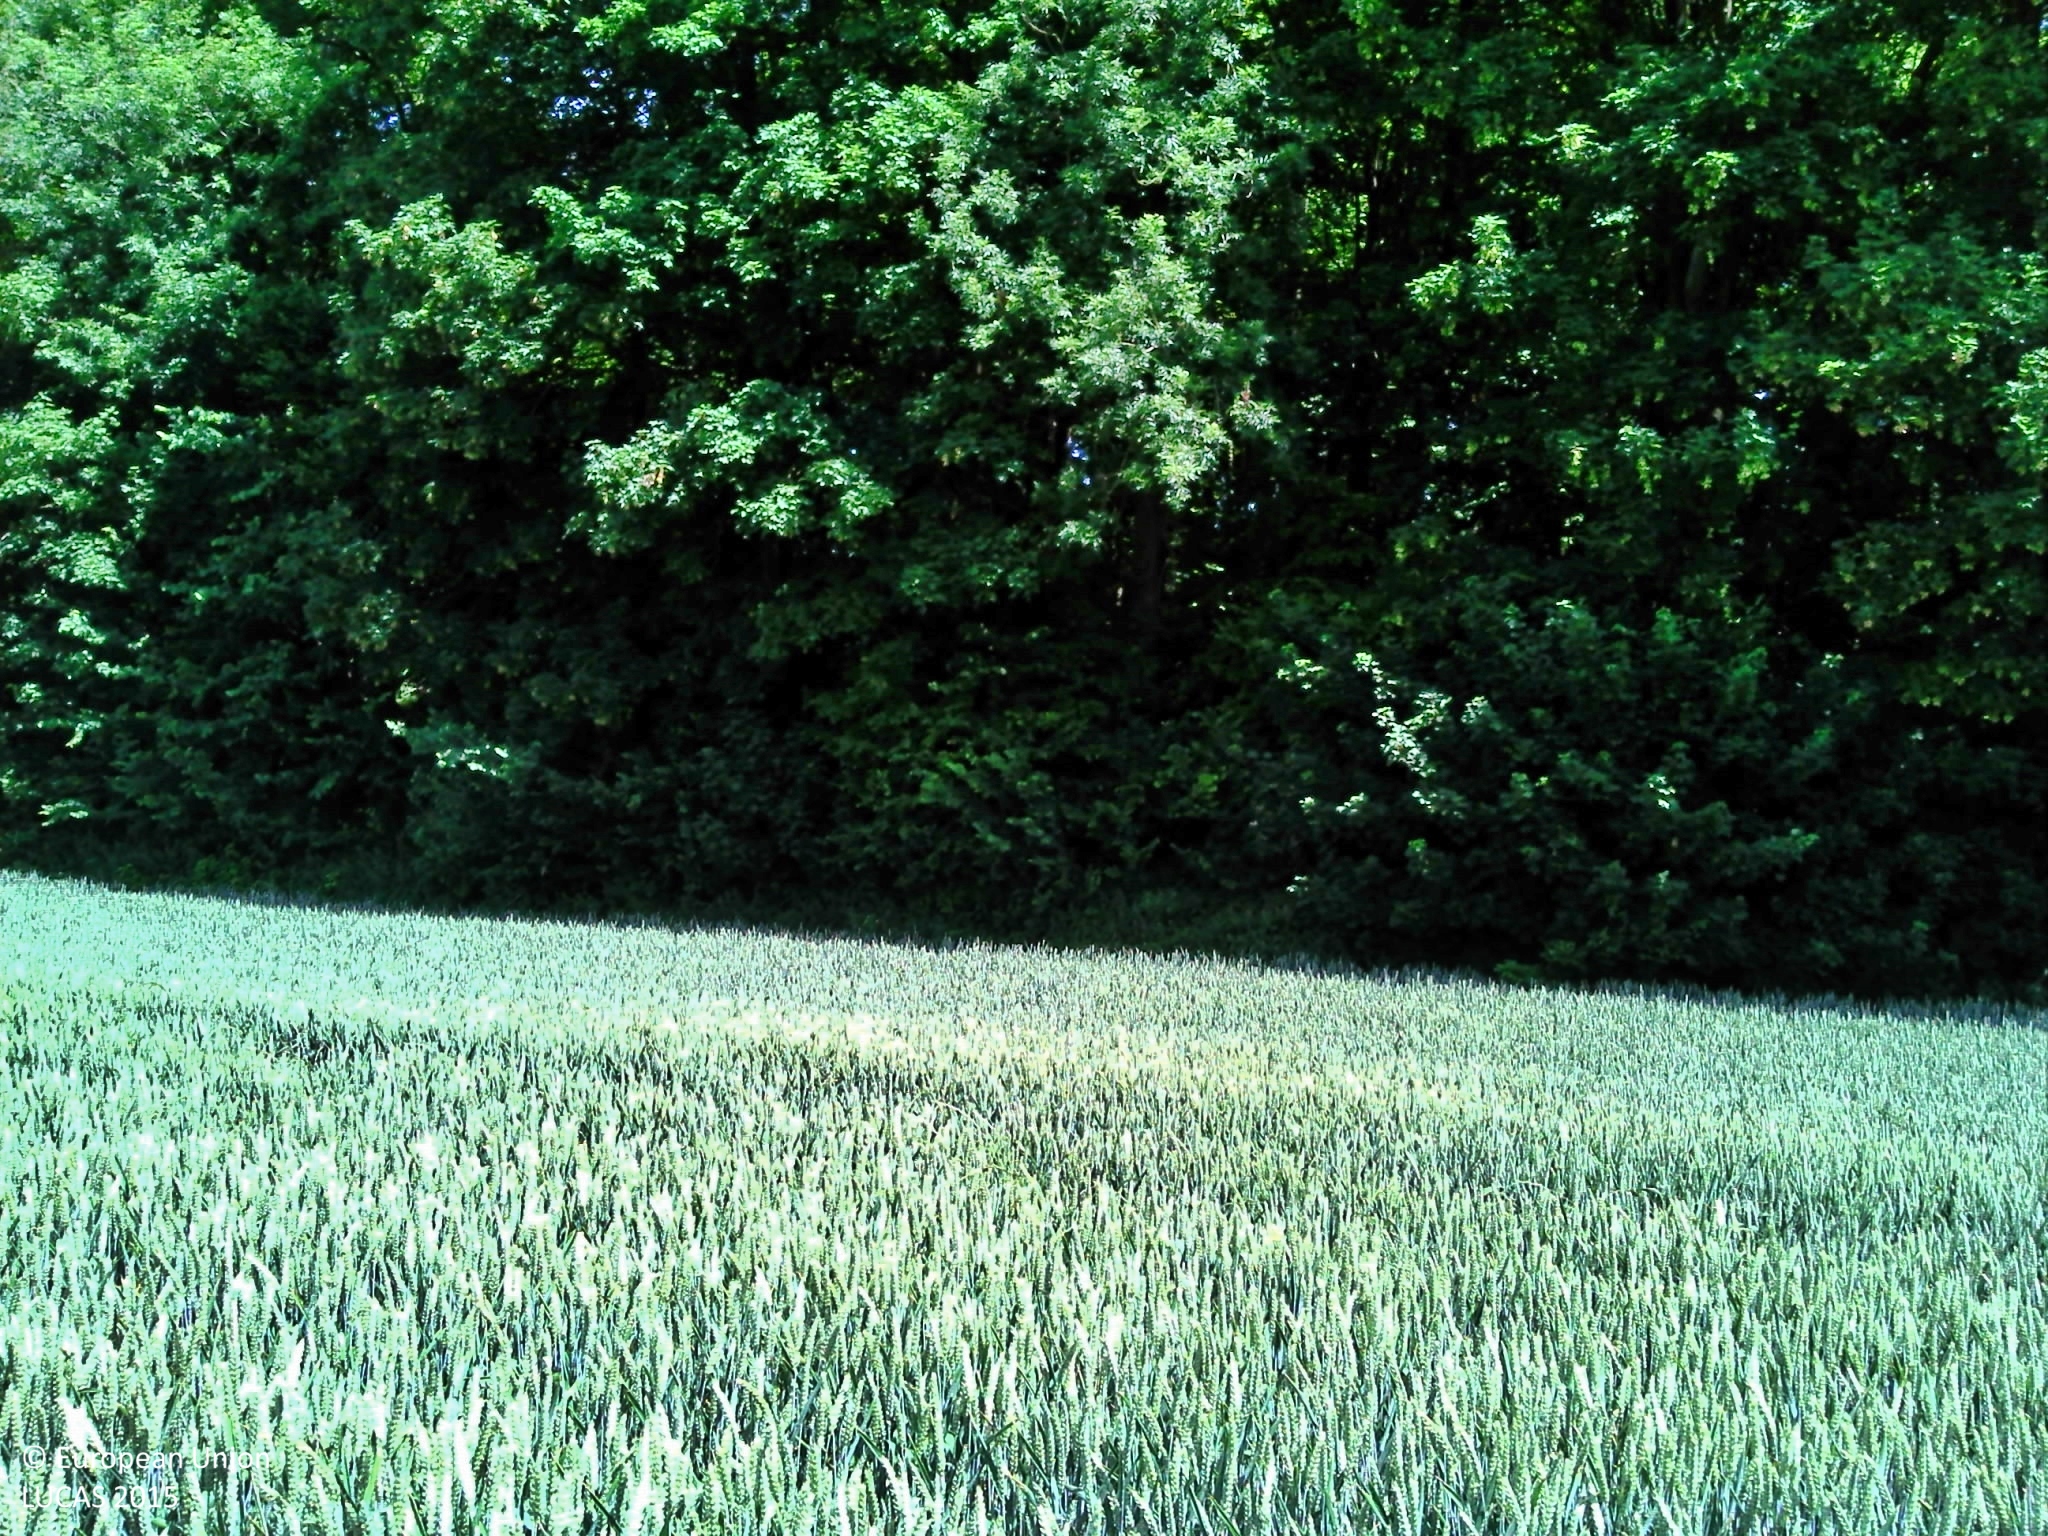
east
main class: Cropland
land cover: Common wheat
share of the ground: > 75 %
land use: Agriculture (excluding fallow land and kitchen gardens)
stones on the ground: < 10 %
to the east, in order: Common wheat; Broadleaved woodland; Groves; Common wheat
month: June
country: FR
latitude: 49.5294
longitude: 2.3467
